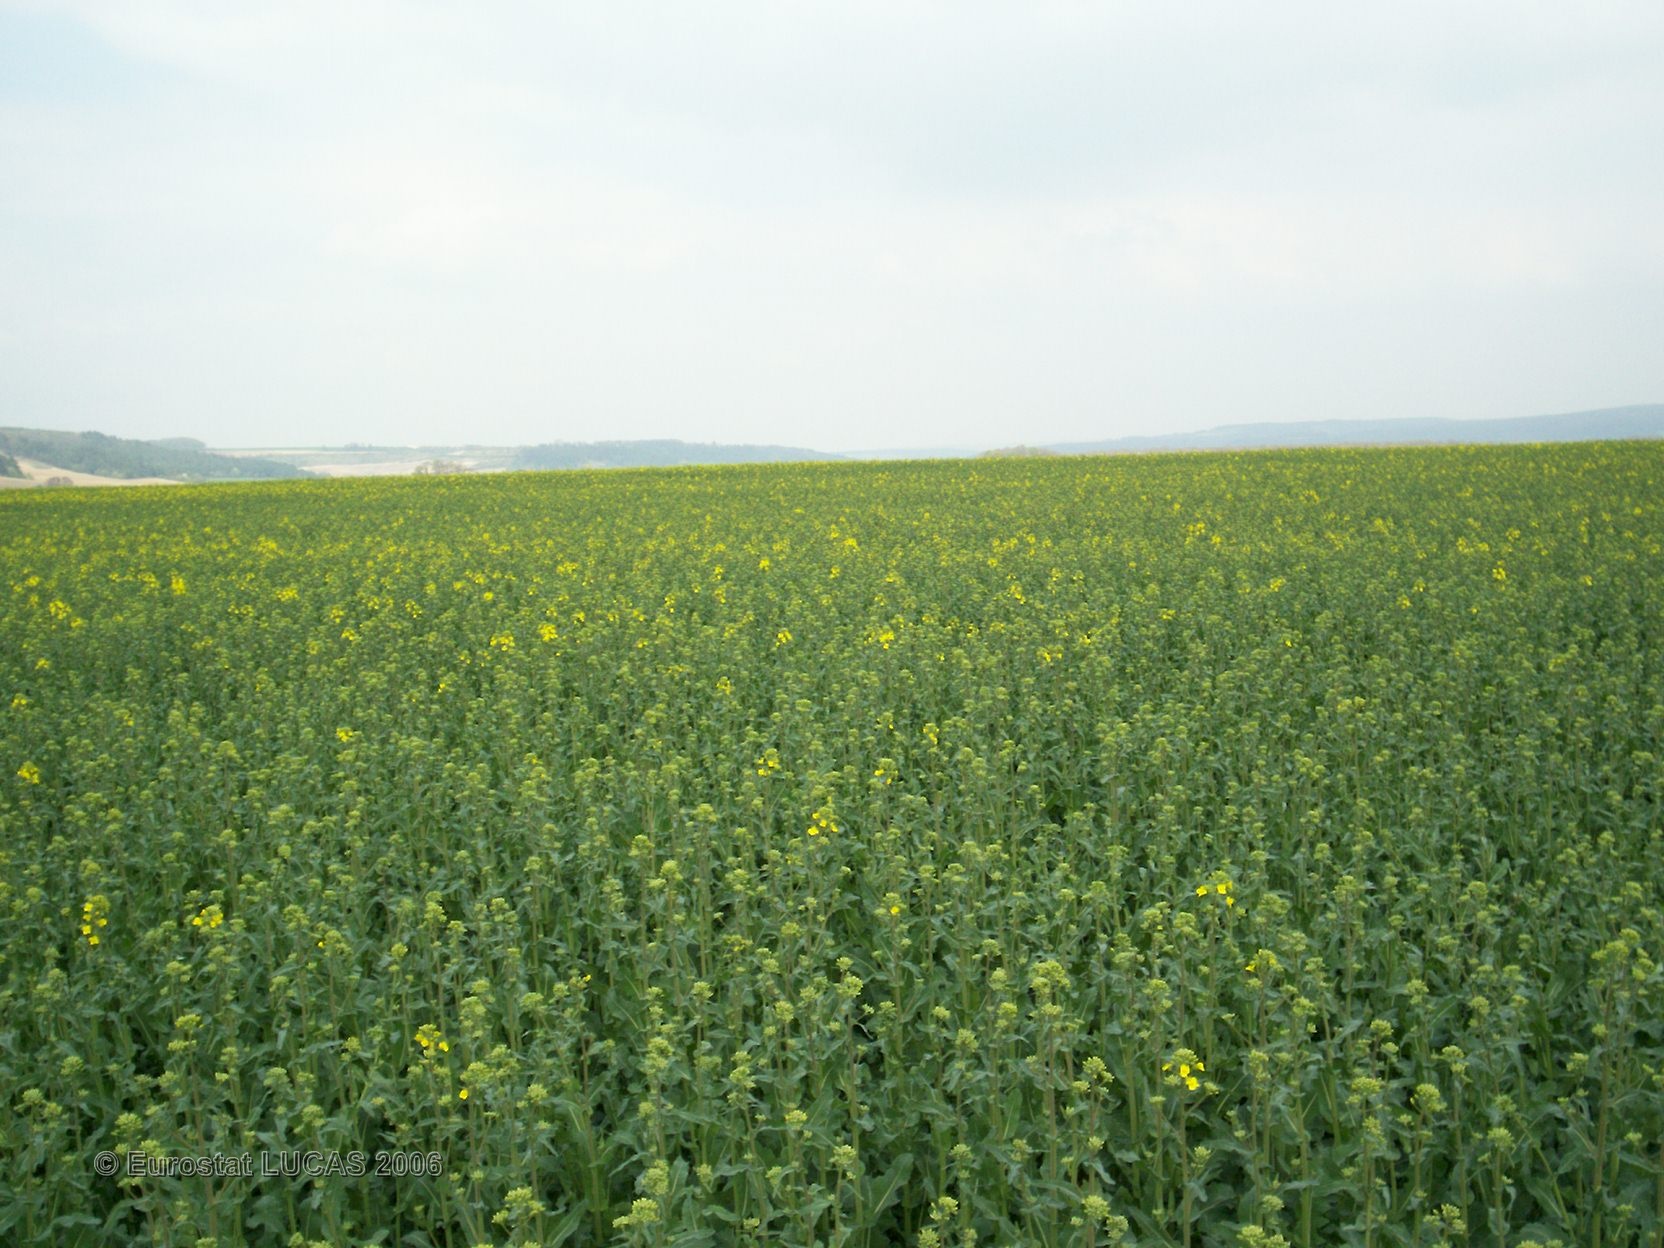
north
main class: Cropland
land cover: Rape and turnip rape
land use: Agriculture (excluding fallow land and kitchen gardens)
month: April
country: FR
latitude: 47.8880
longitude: 4.5017
